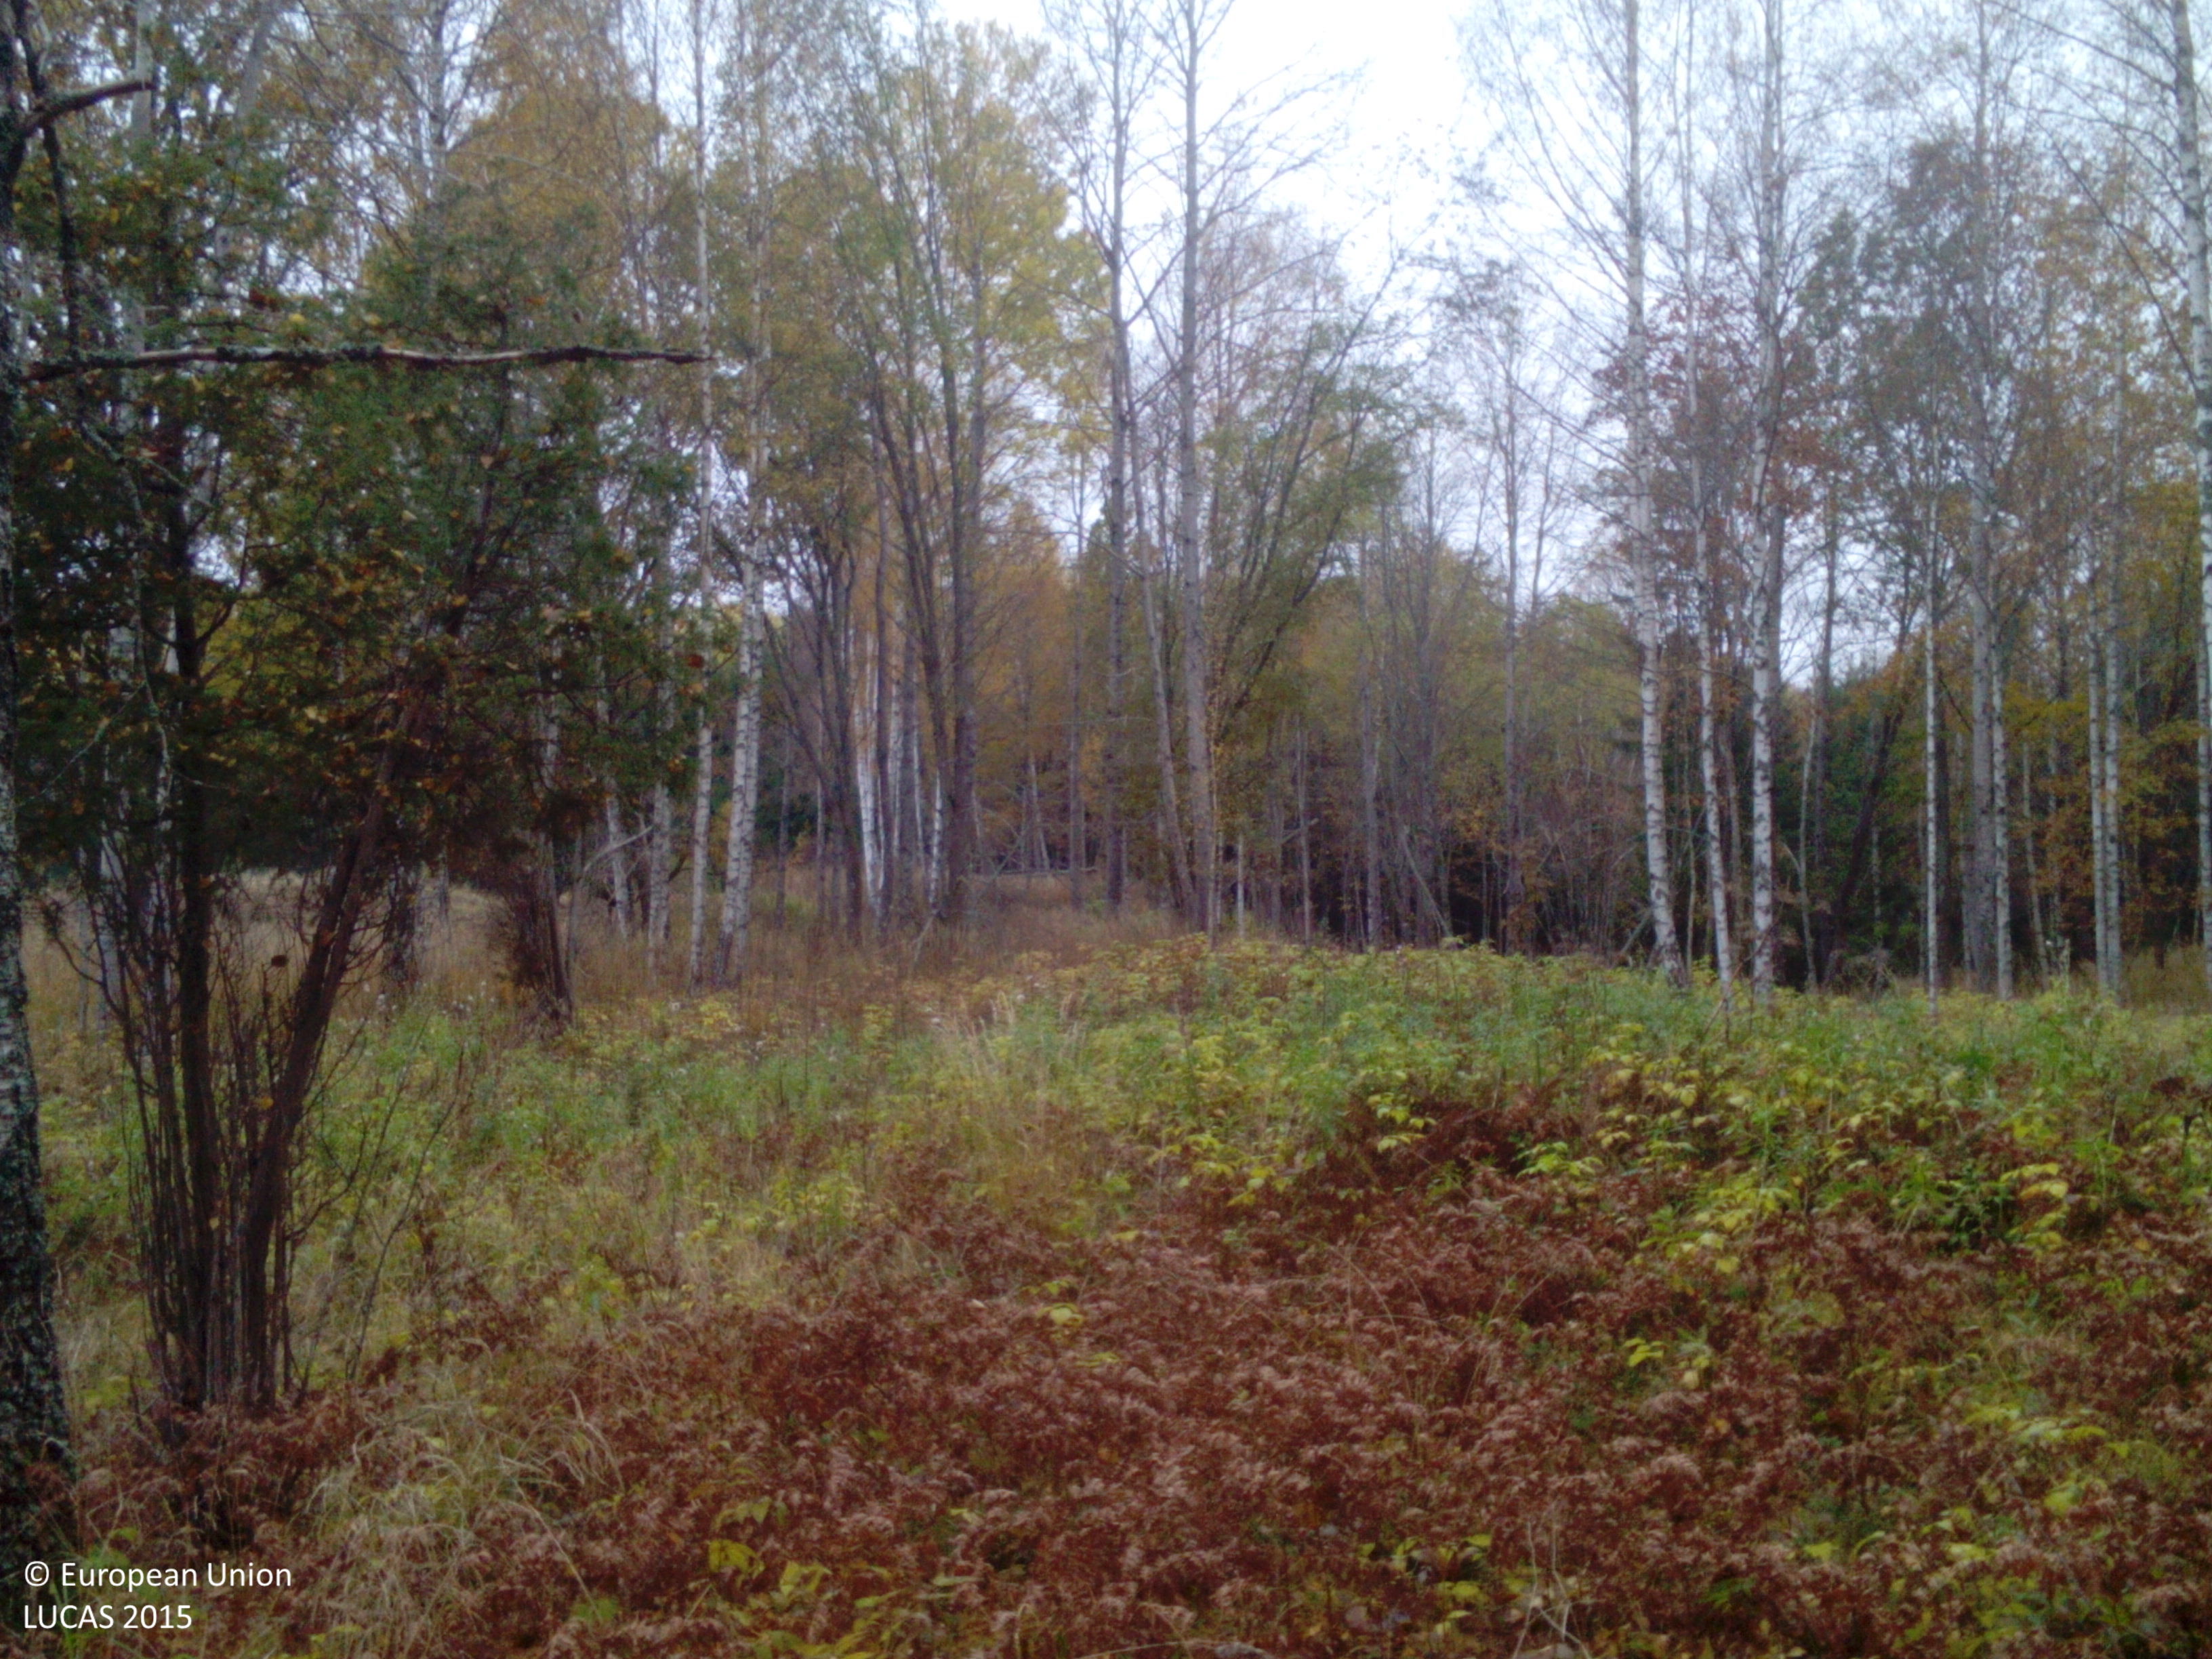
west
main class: Woodland
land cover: Broadleaved woodland
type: hemiboreal forest and nemoral coniferous forest and mixed broadleaved-coniferous forest
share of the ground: > 75 %
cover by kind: broadleaved forest trees 80 %, herbaceous plants 20 %
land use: Forestry
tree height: > 5 m
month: October
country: SE
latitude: 59.0862
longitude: 16.2235
